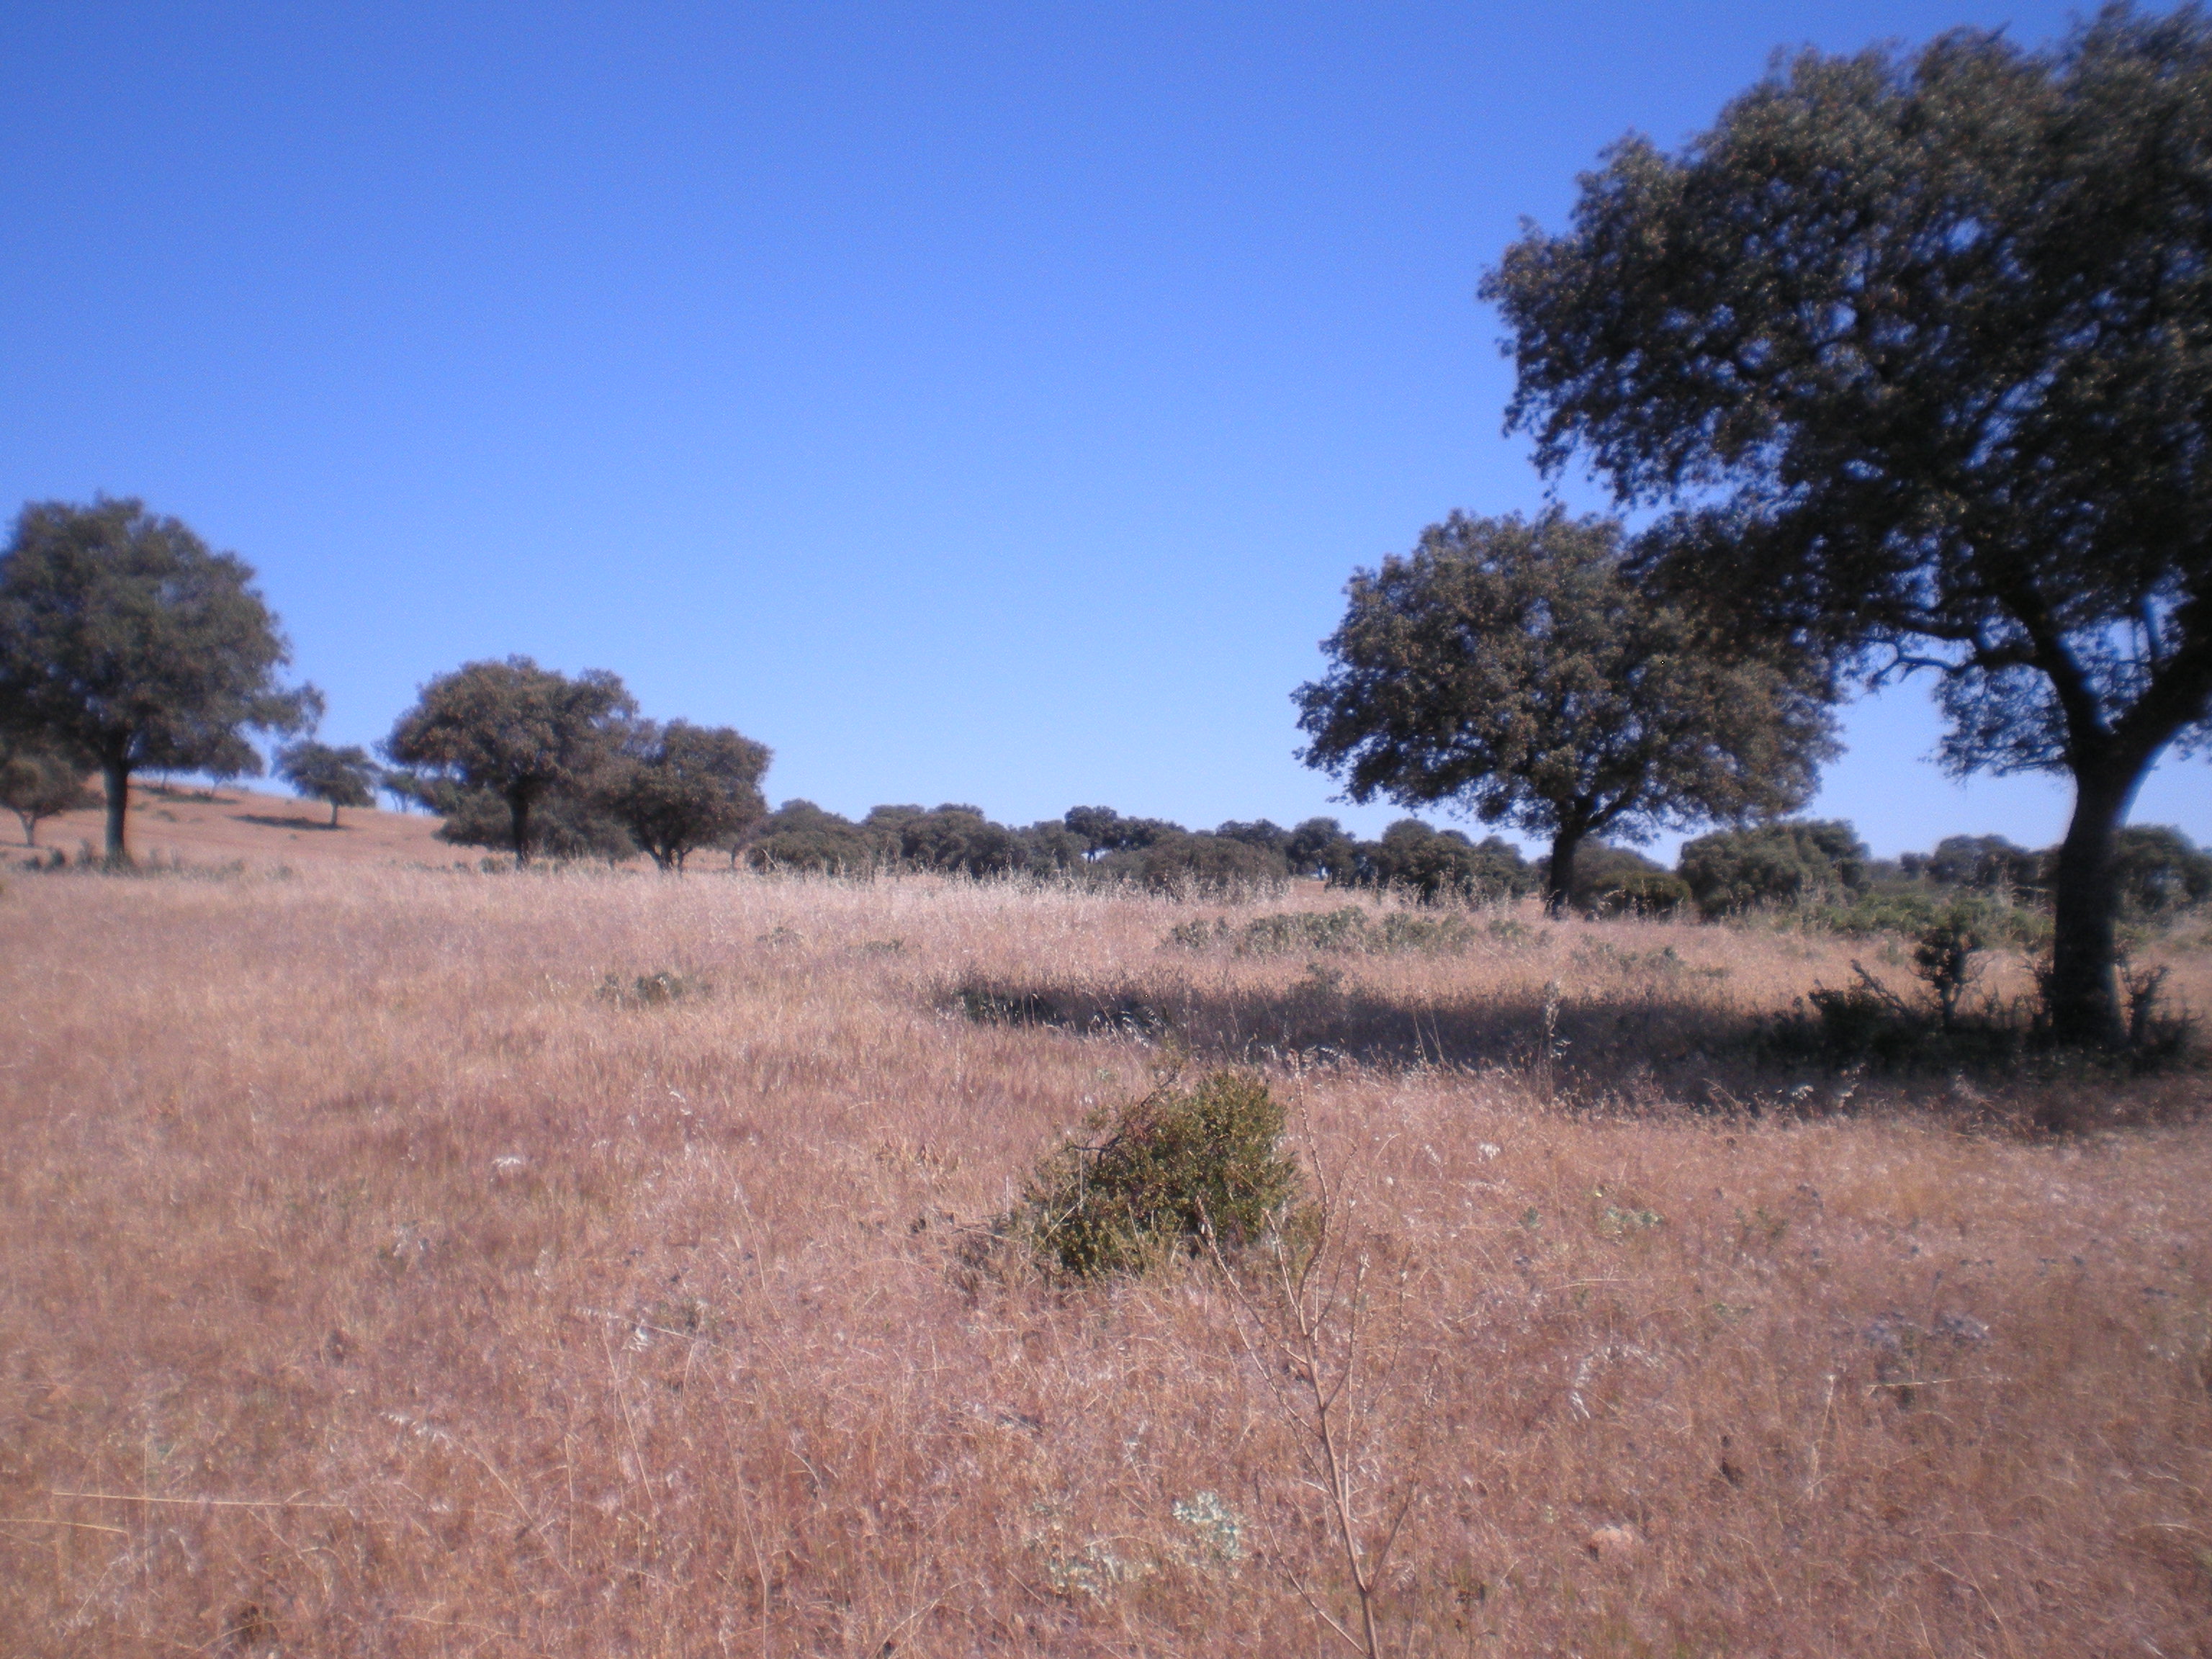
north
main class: Grassland
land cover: Spontaneously vegetated surfaces
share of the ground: 10 - 25 %
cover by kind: unconsolidated bare surface 90 %, herbaceous plants 10 %
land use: Fallow land
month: May
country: ES
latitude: 38.4602
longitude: -3.4269
